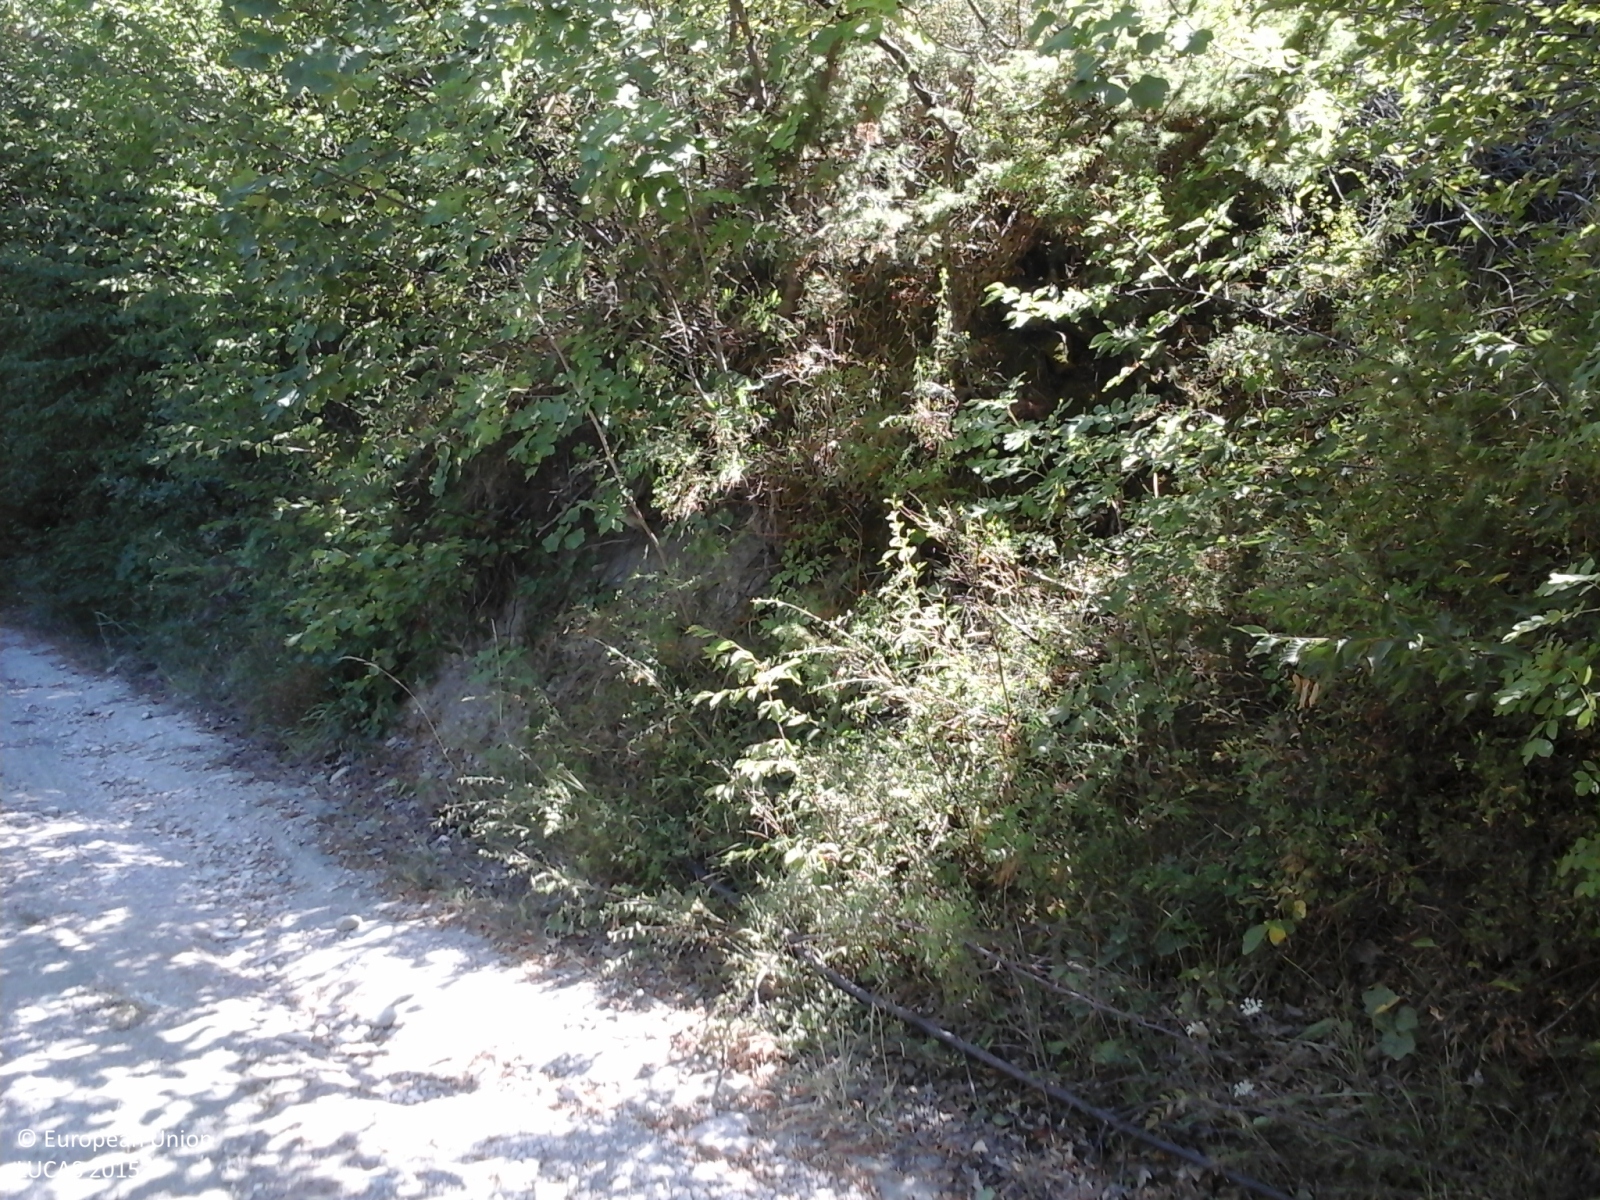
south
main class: Woodland
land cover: Broadleaved woodland
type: thermophilous deciduous forest
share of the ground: > 75 %
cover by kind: broadleaved forest trees 100 %
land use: Forestry
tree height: > 5 m
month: August
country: IT
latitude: 43.5297
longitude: 12.3572
